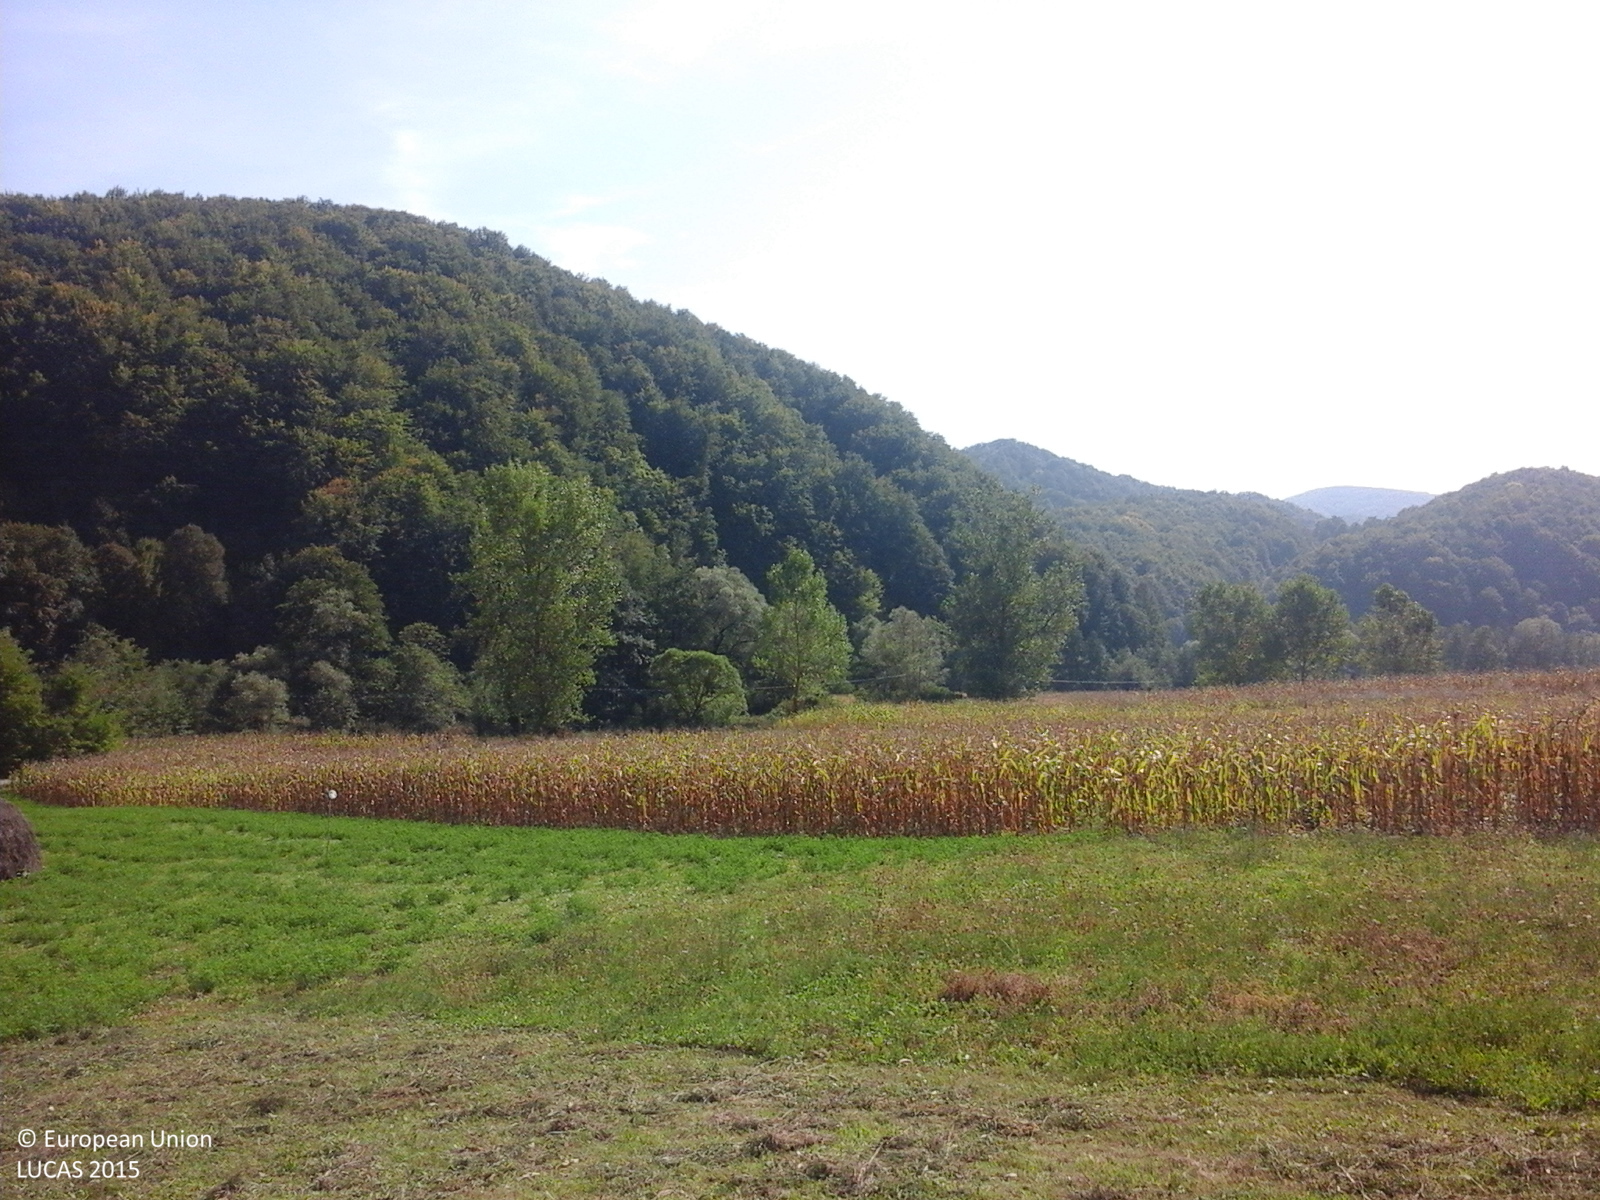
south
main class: Grassland
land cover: Grassland without tree/shrub cover
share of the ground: > 75 %
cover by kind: herbaceous plants 100 %
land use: Agriculture (excluding fallow land and kitchen gardens)
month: September
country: RO
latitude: 47.3177
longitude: 23.7704
